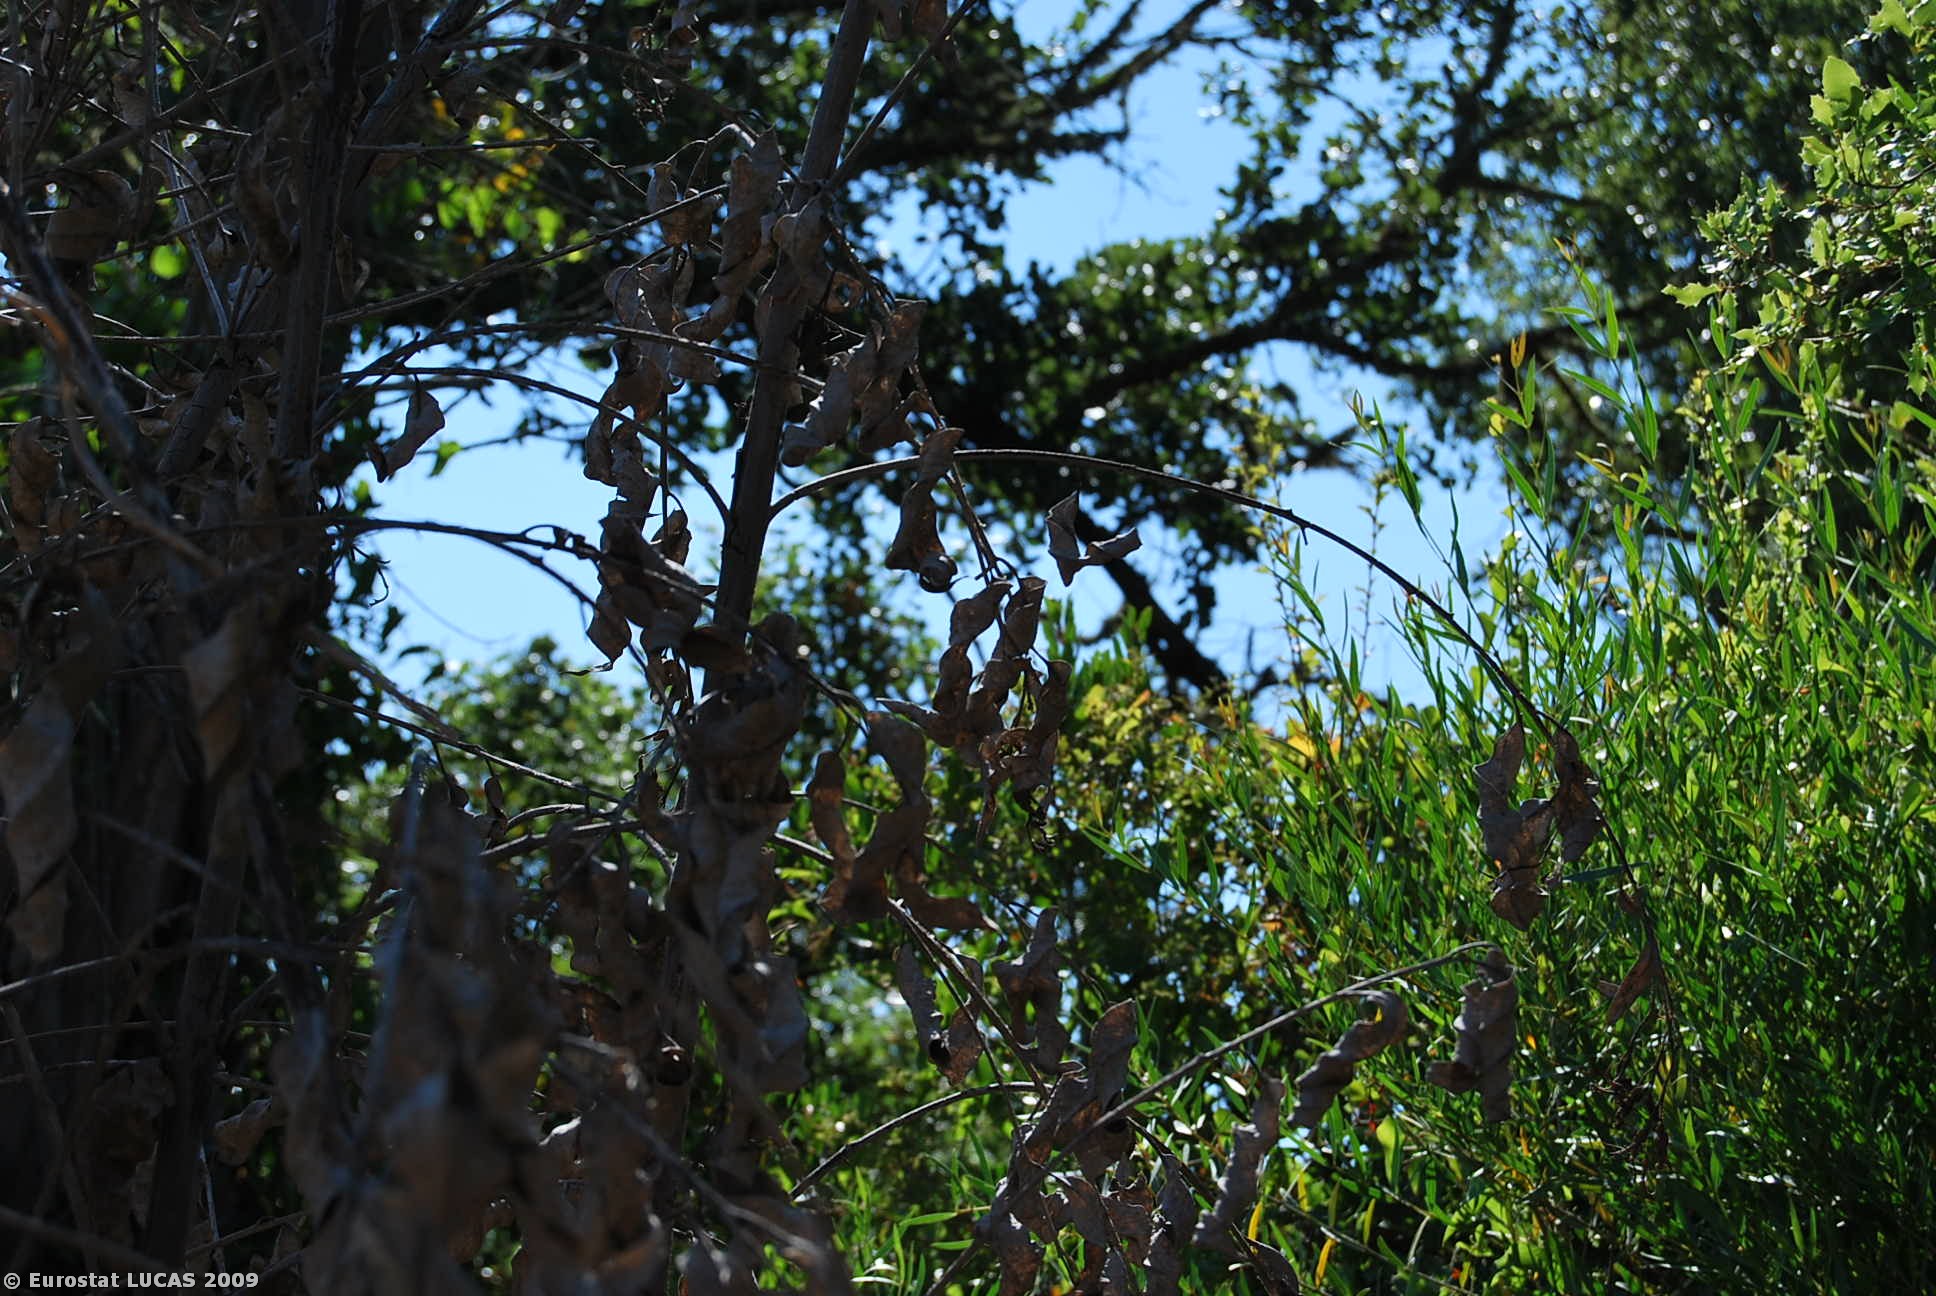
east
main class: Woodland
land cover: Broadleaved woodland
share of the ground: 25 - 50 %
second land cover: Shrubland with sparse tree cover
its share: 50 - 75 %
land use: Unused
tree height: < 5 m
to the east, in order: Broadleaved woodland; Shrubland with sparse tree cover; Rivers and streams; Shrubland with sparse tree cover; Broadleaved woodland; Rivers and streams; Broadleaved woodland; Tracks; Broadleaved woodland
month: June
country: PT
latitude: 37.9599
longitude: -8.5619
